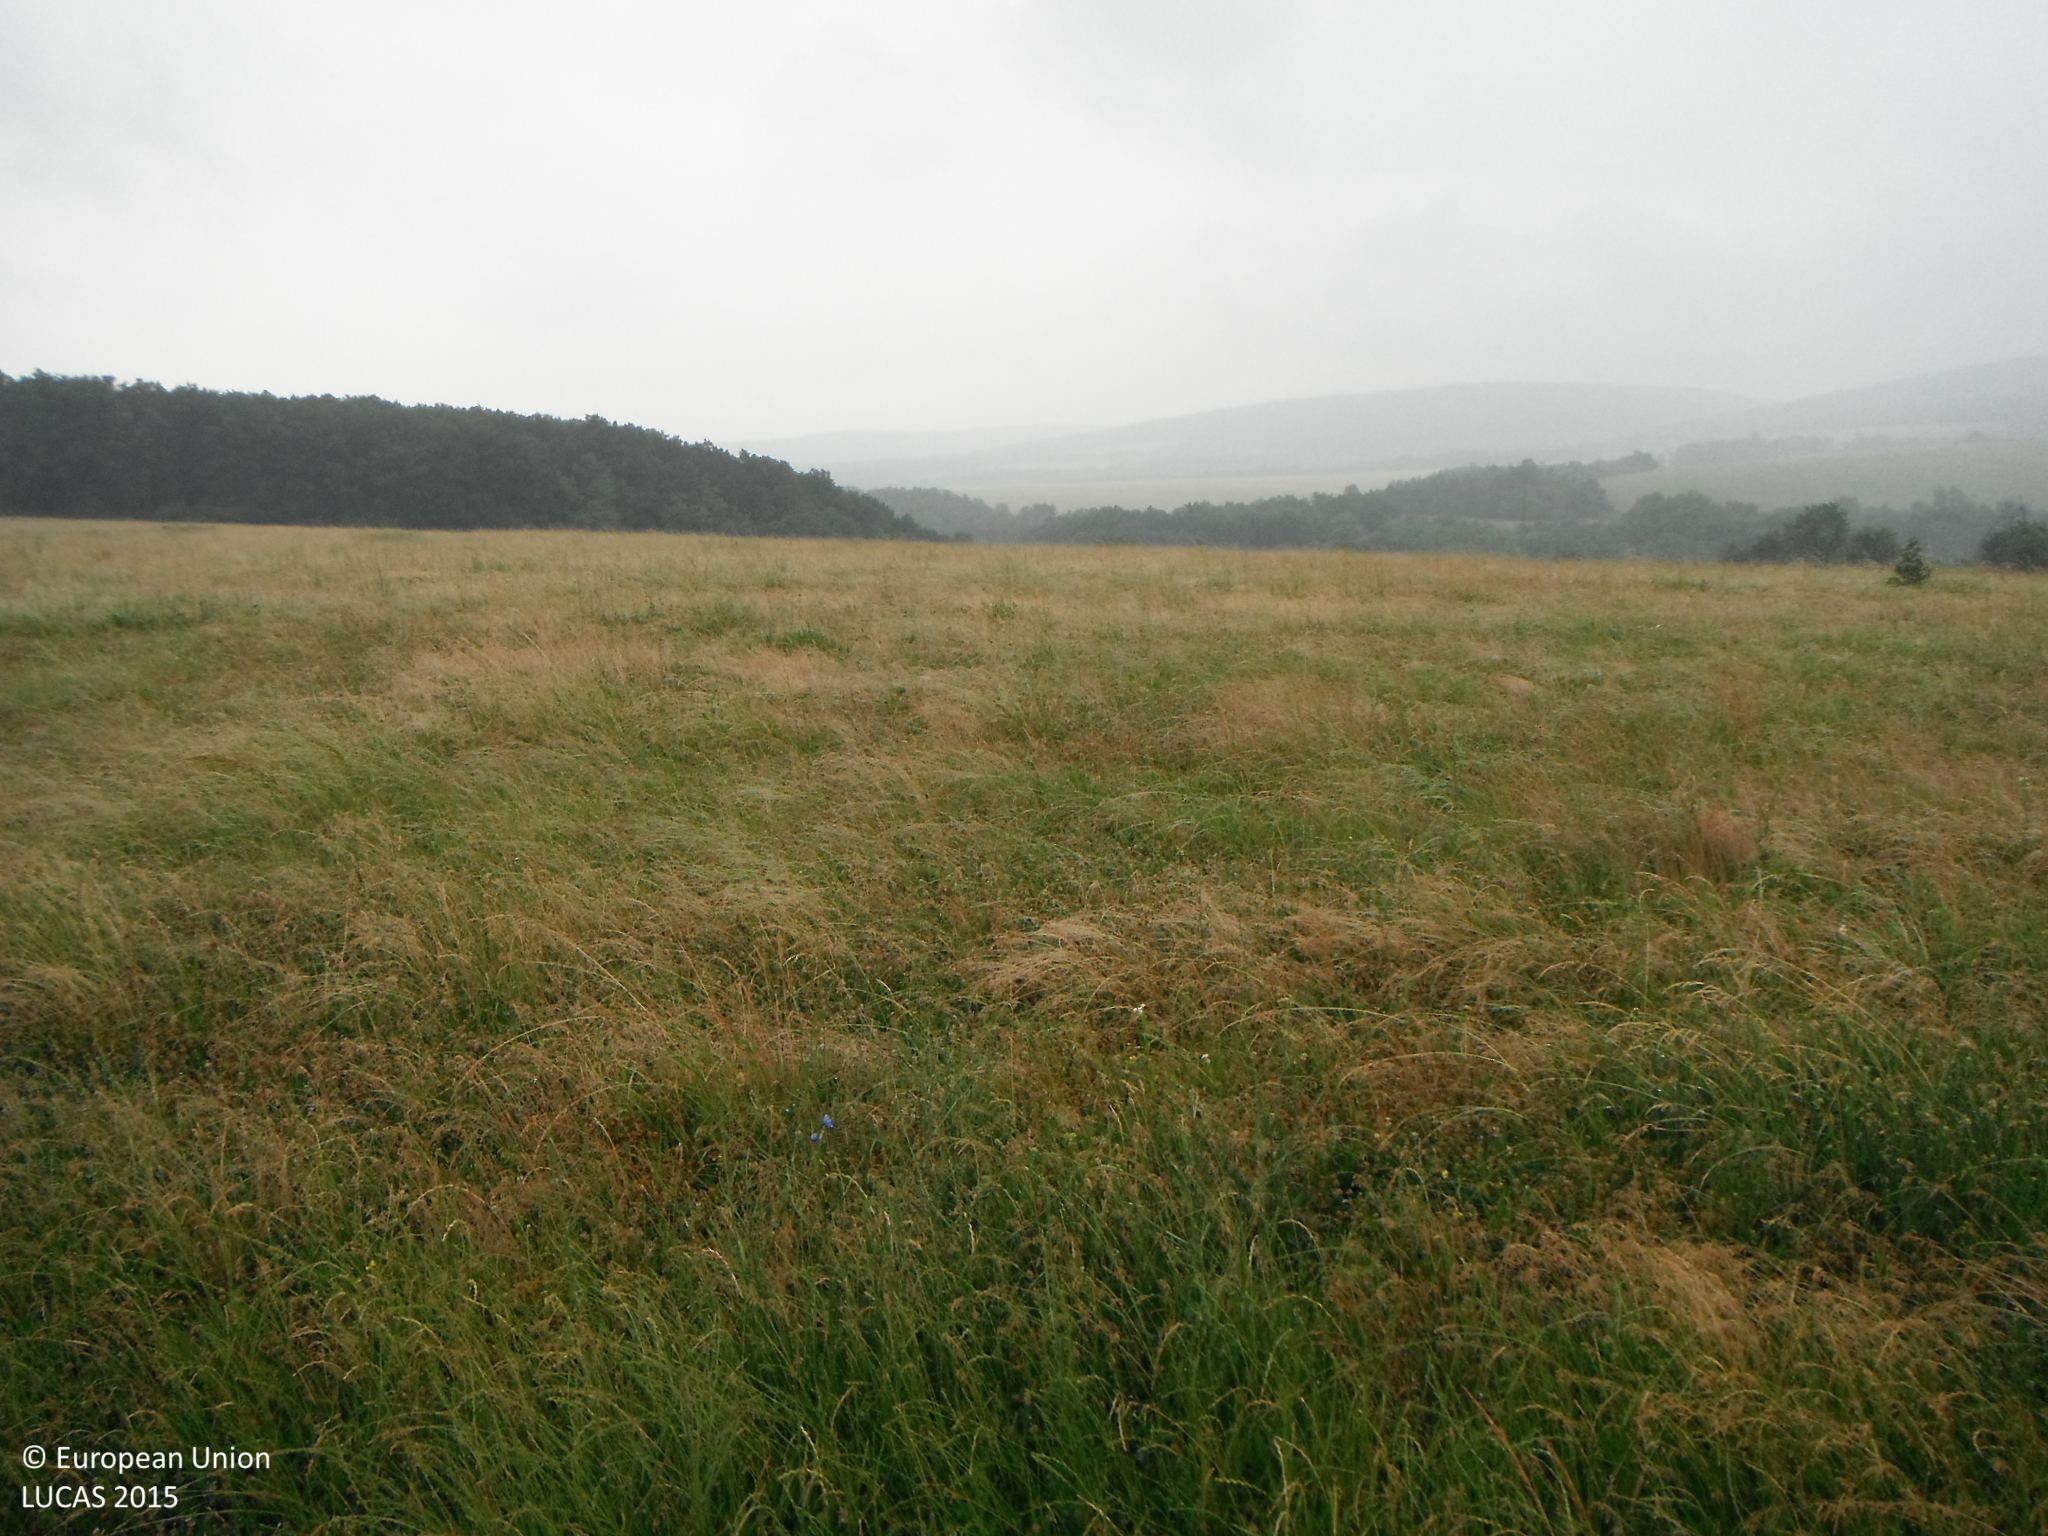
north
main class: Grassland
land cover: Grassland without tree/shrub cover
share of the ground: > 75 %
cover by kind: herbaceous plants 100 %
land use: Agriculture (excluding fallow land and kitchen gardens)
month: June
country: SK
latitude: 48.1235
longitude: 19.0345
